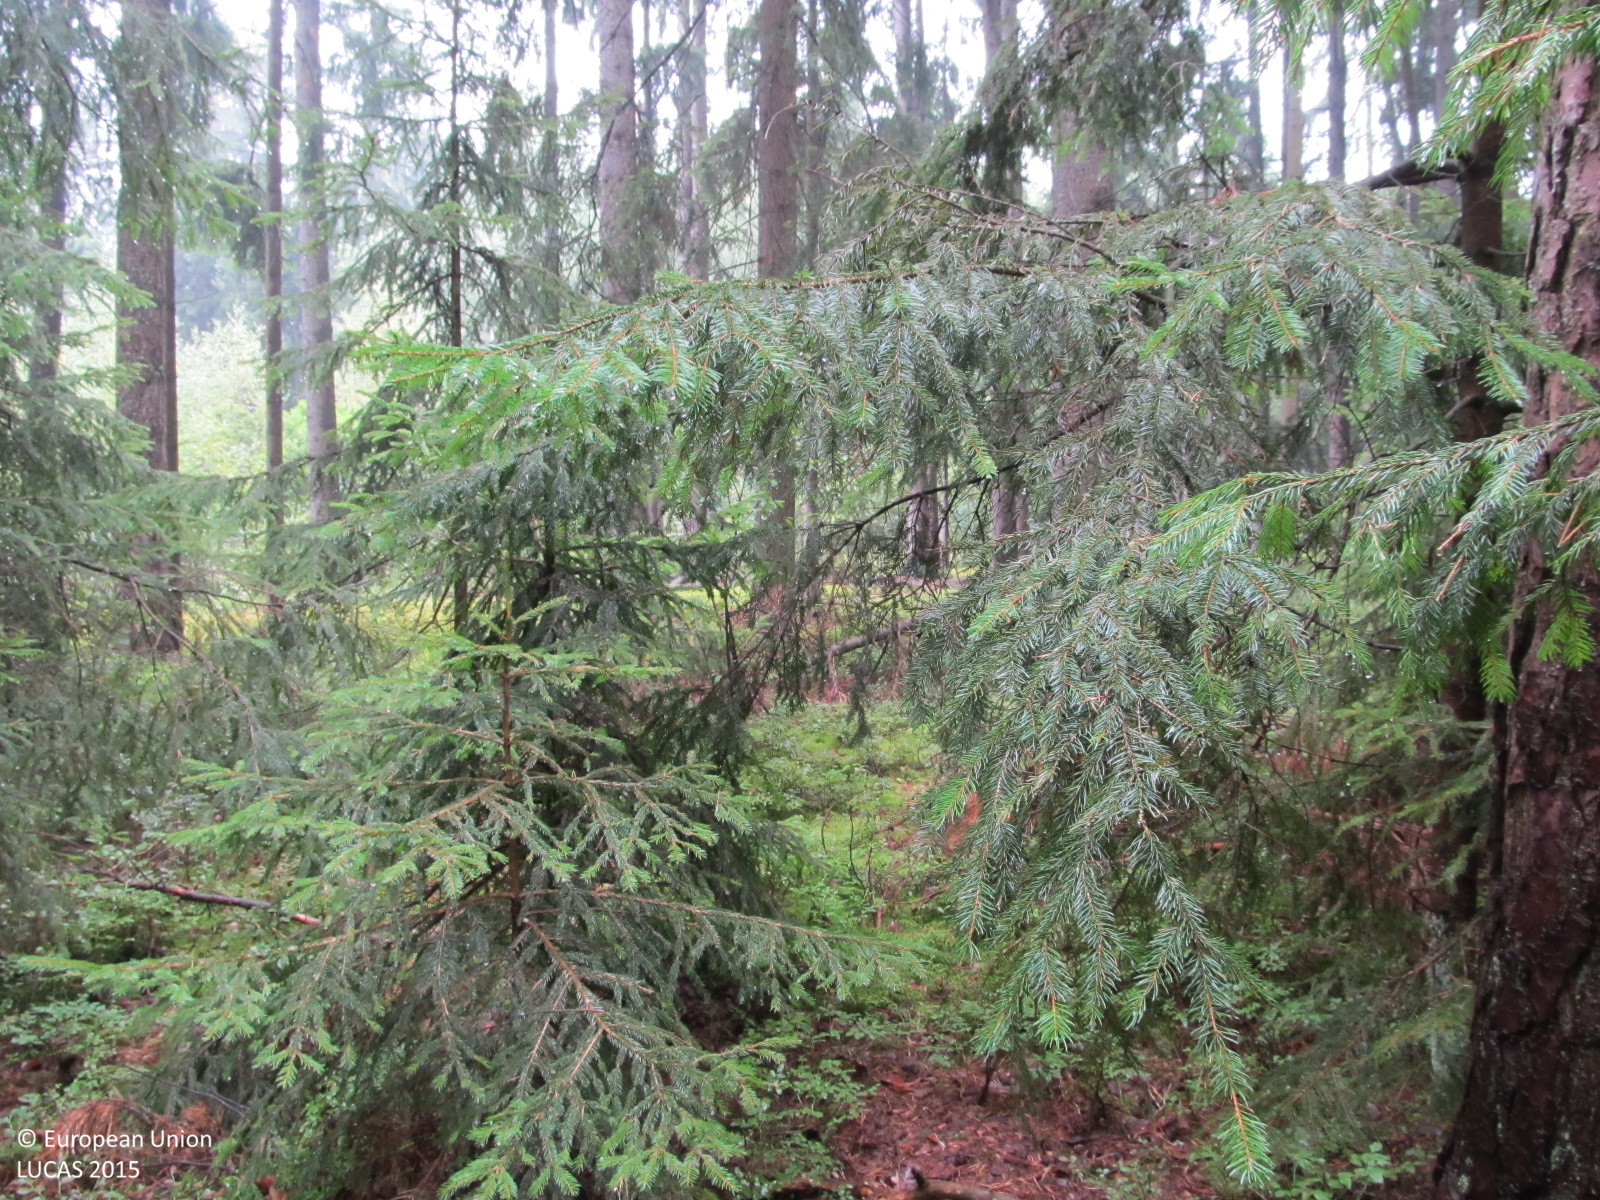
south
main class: Woodland
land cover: Spruce dominated coniferous woodland
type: hemiboreal forest and nemoral coniferous forest and mixed broadleaved-coniferous forest
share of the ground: > 75 %
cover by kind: coniferous forest trees 70 %, herbaceous plants 20 %, shrubs 10 %
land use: Forestry
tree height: > 5 m
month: August
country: AT
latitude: 48.7032
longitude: 15.4245
